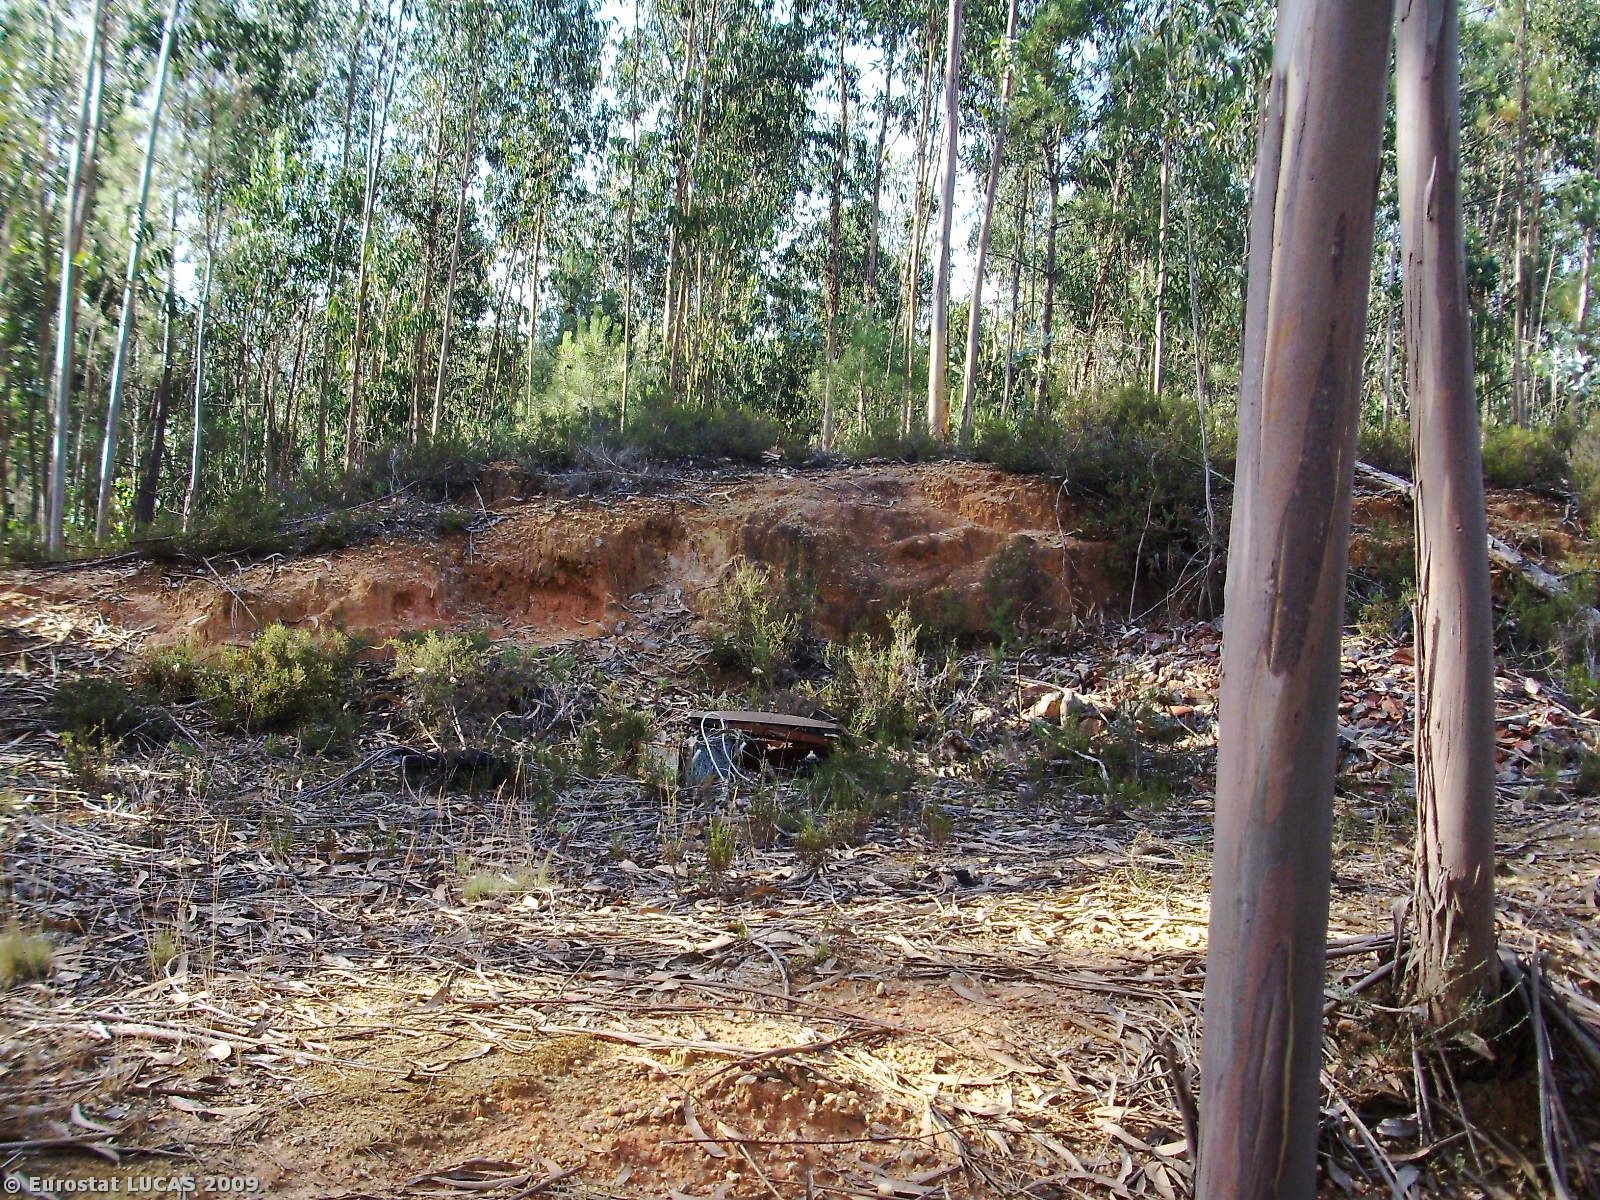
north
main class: Woodland
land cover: Broadleaved woodland
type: plantations and self-sown exotic forest
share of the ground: 50 - 75 %
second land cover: Bare land
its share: 25 - 50 %
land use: Forestry
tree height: > 5 m
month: July
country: PT
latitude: 39.3662
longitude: -8.8478
